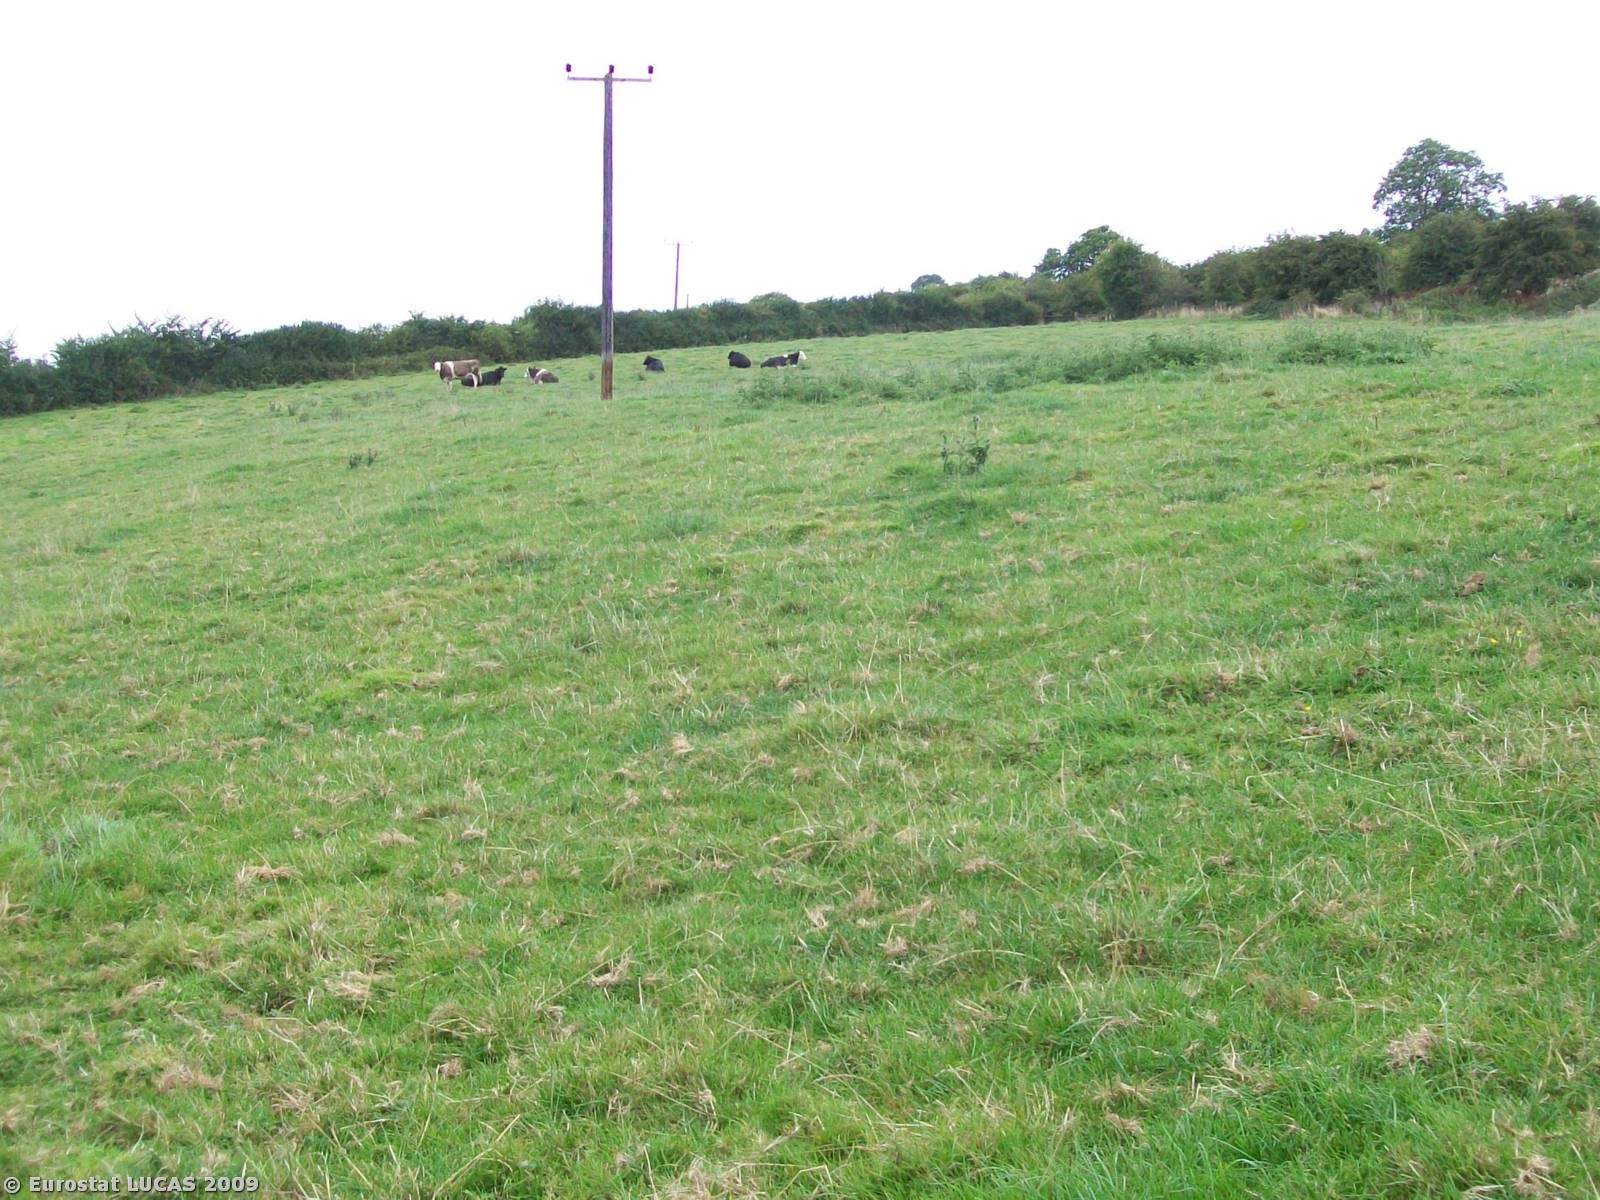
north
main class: Grassland
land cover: Grassland without tree/shrub cover
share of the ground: > 75 %
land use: Agriculture (excluding fallow land and kitchen gardens)
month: August
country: GB
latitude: 52.1161
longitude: -1.2191
